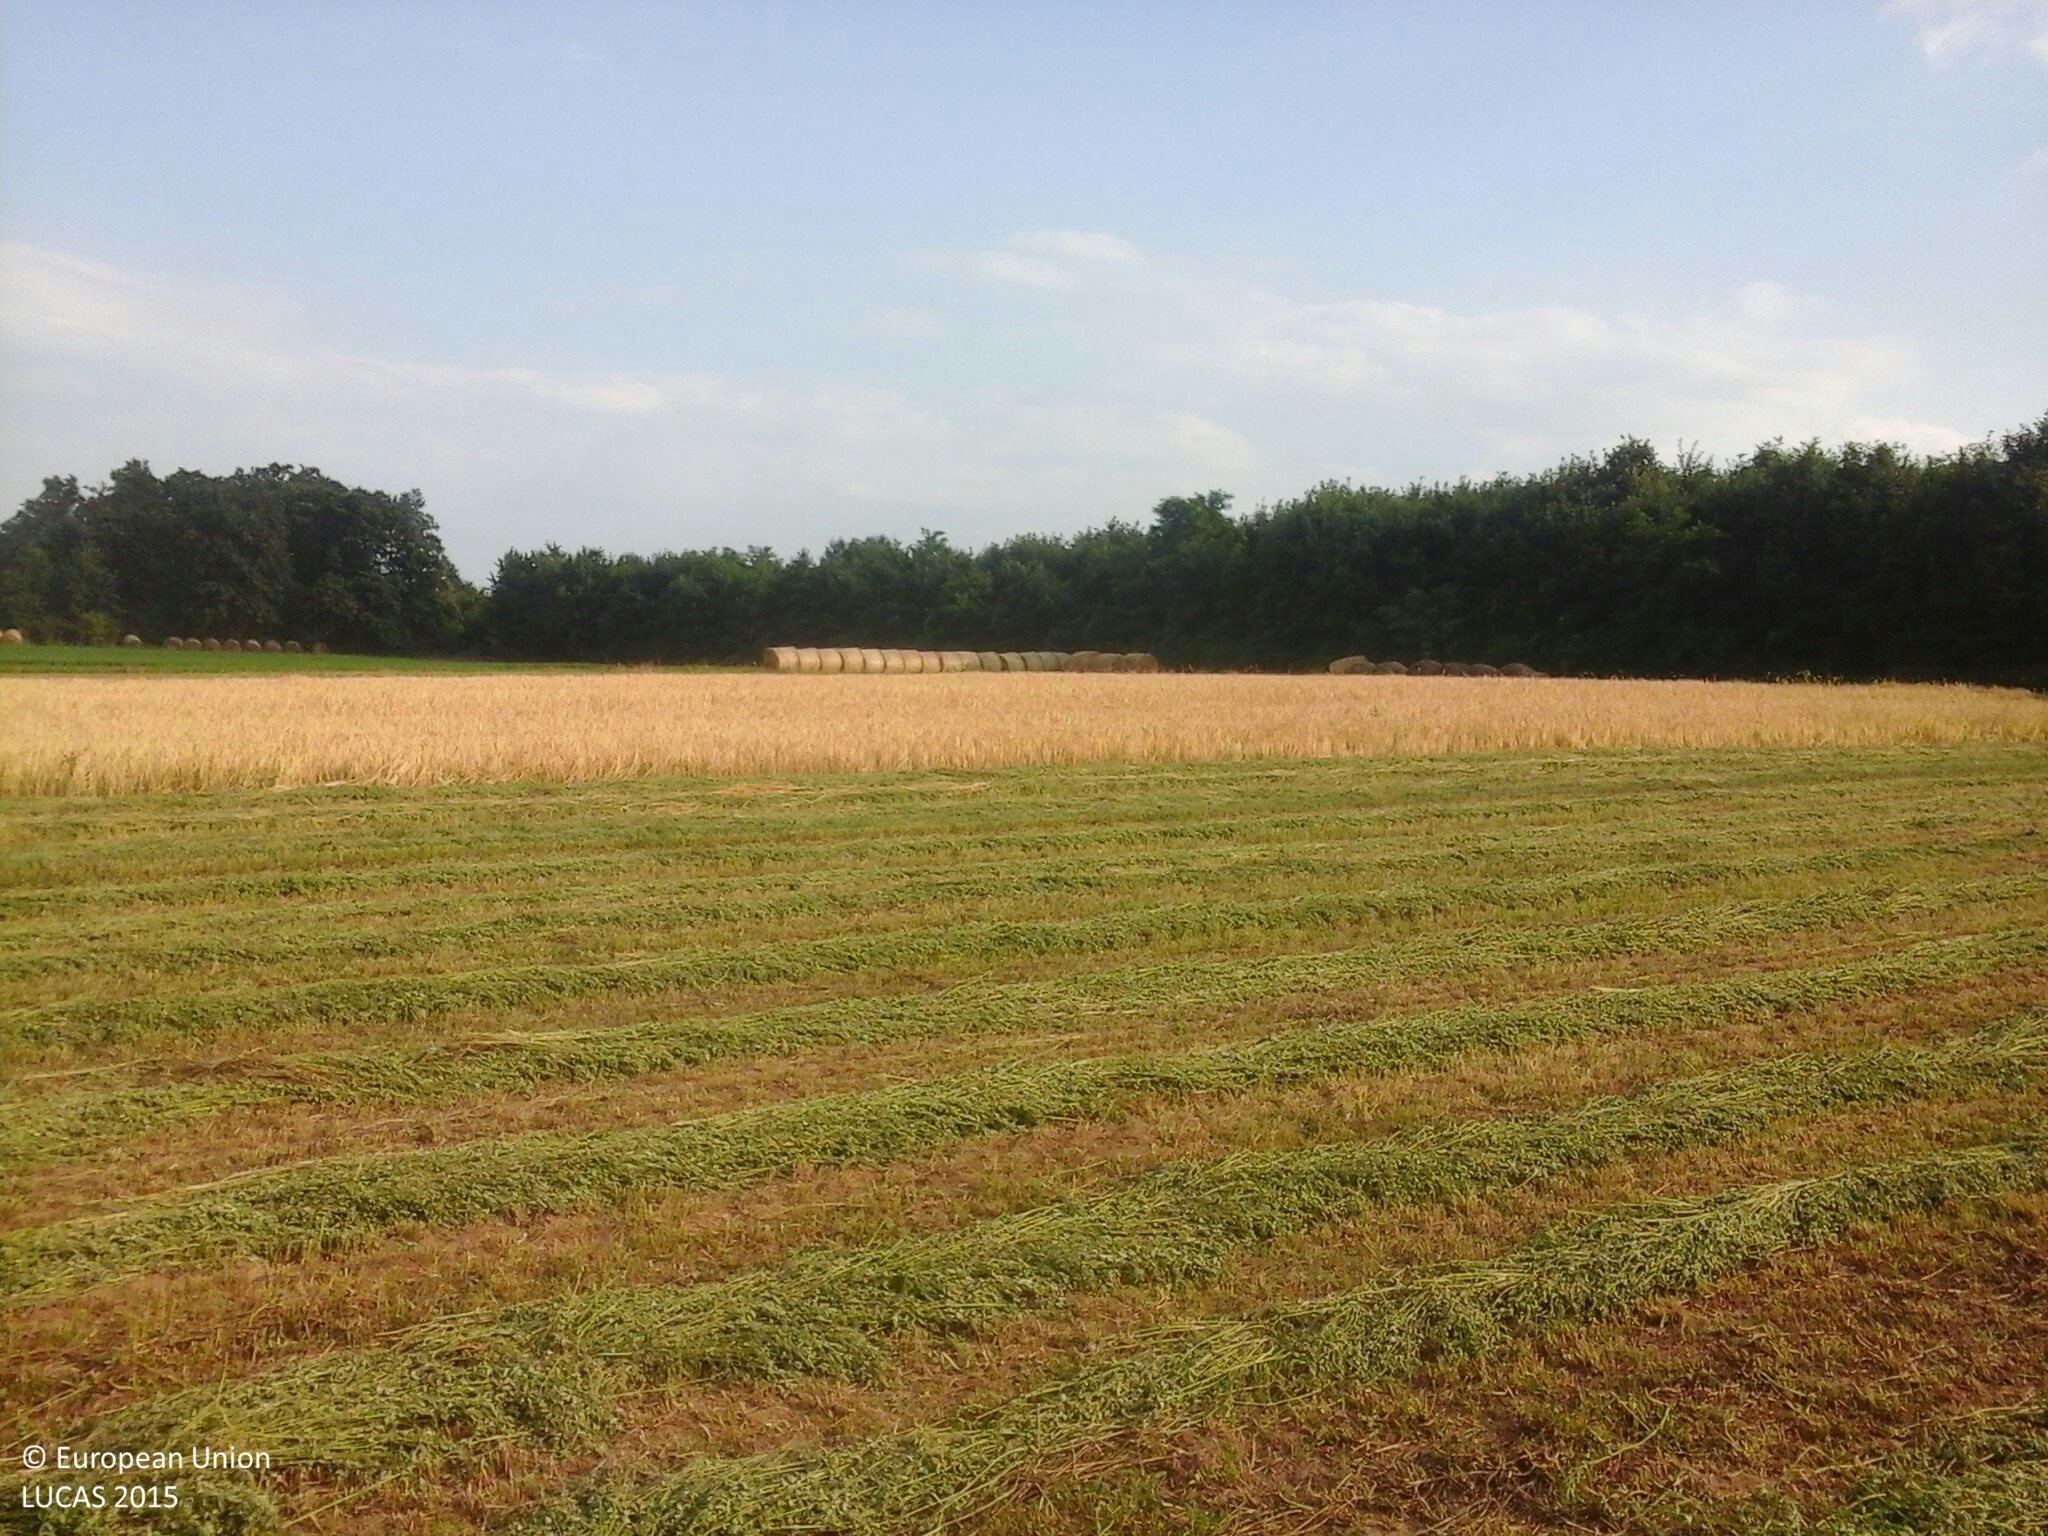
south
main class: Cropland
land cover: Lucerne
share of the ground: 25 - 50 %
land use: Agriculture (excluding fallow land and kitchen gardens)
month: July
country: HU
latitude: 47.0720
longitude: 17.8969
